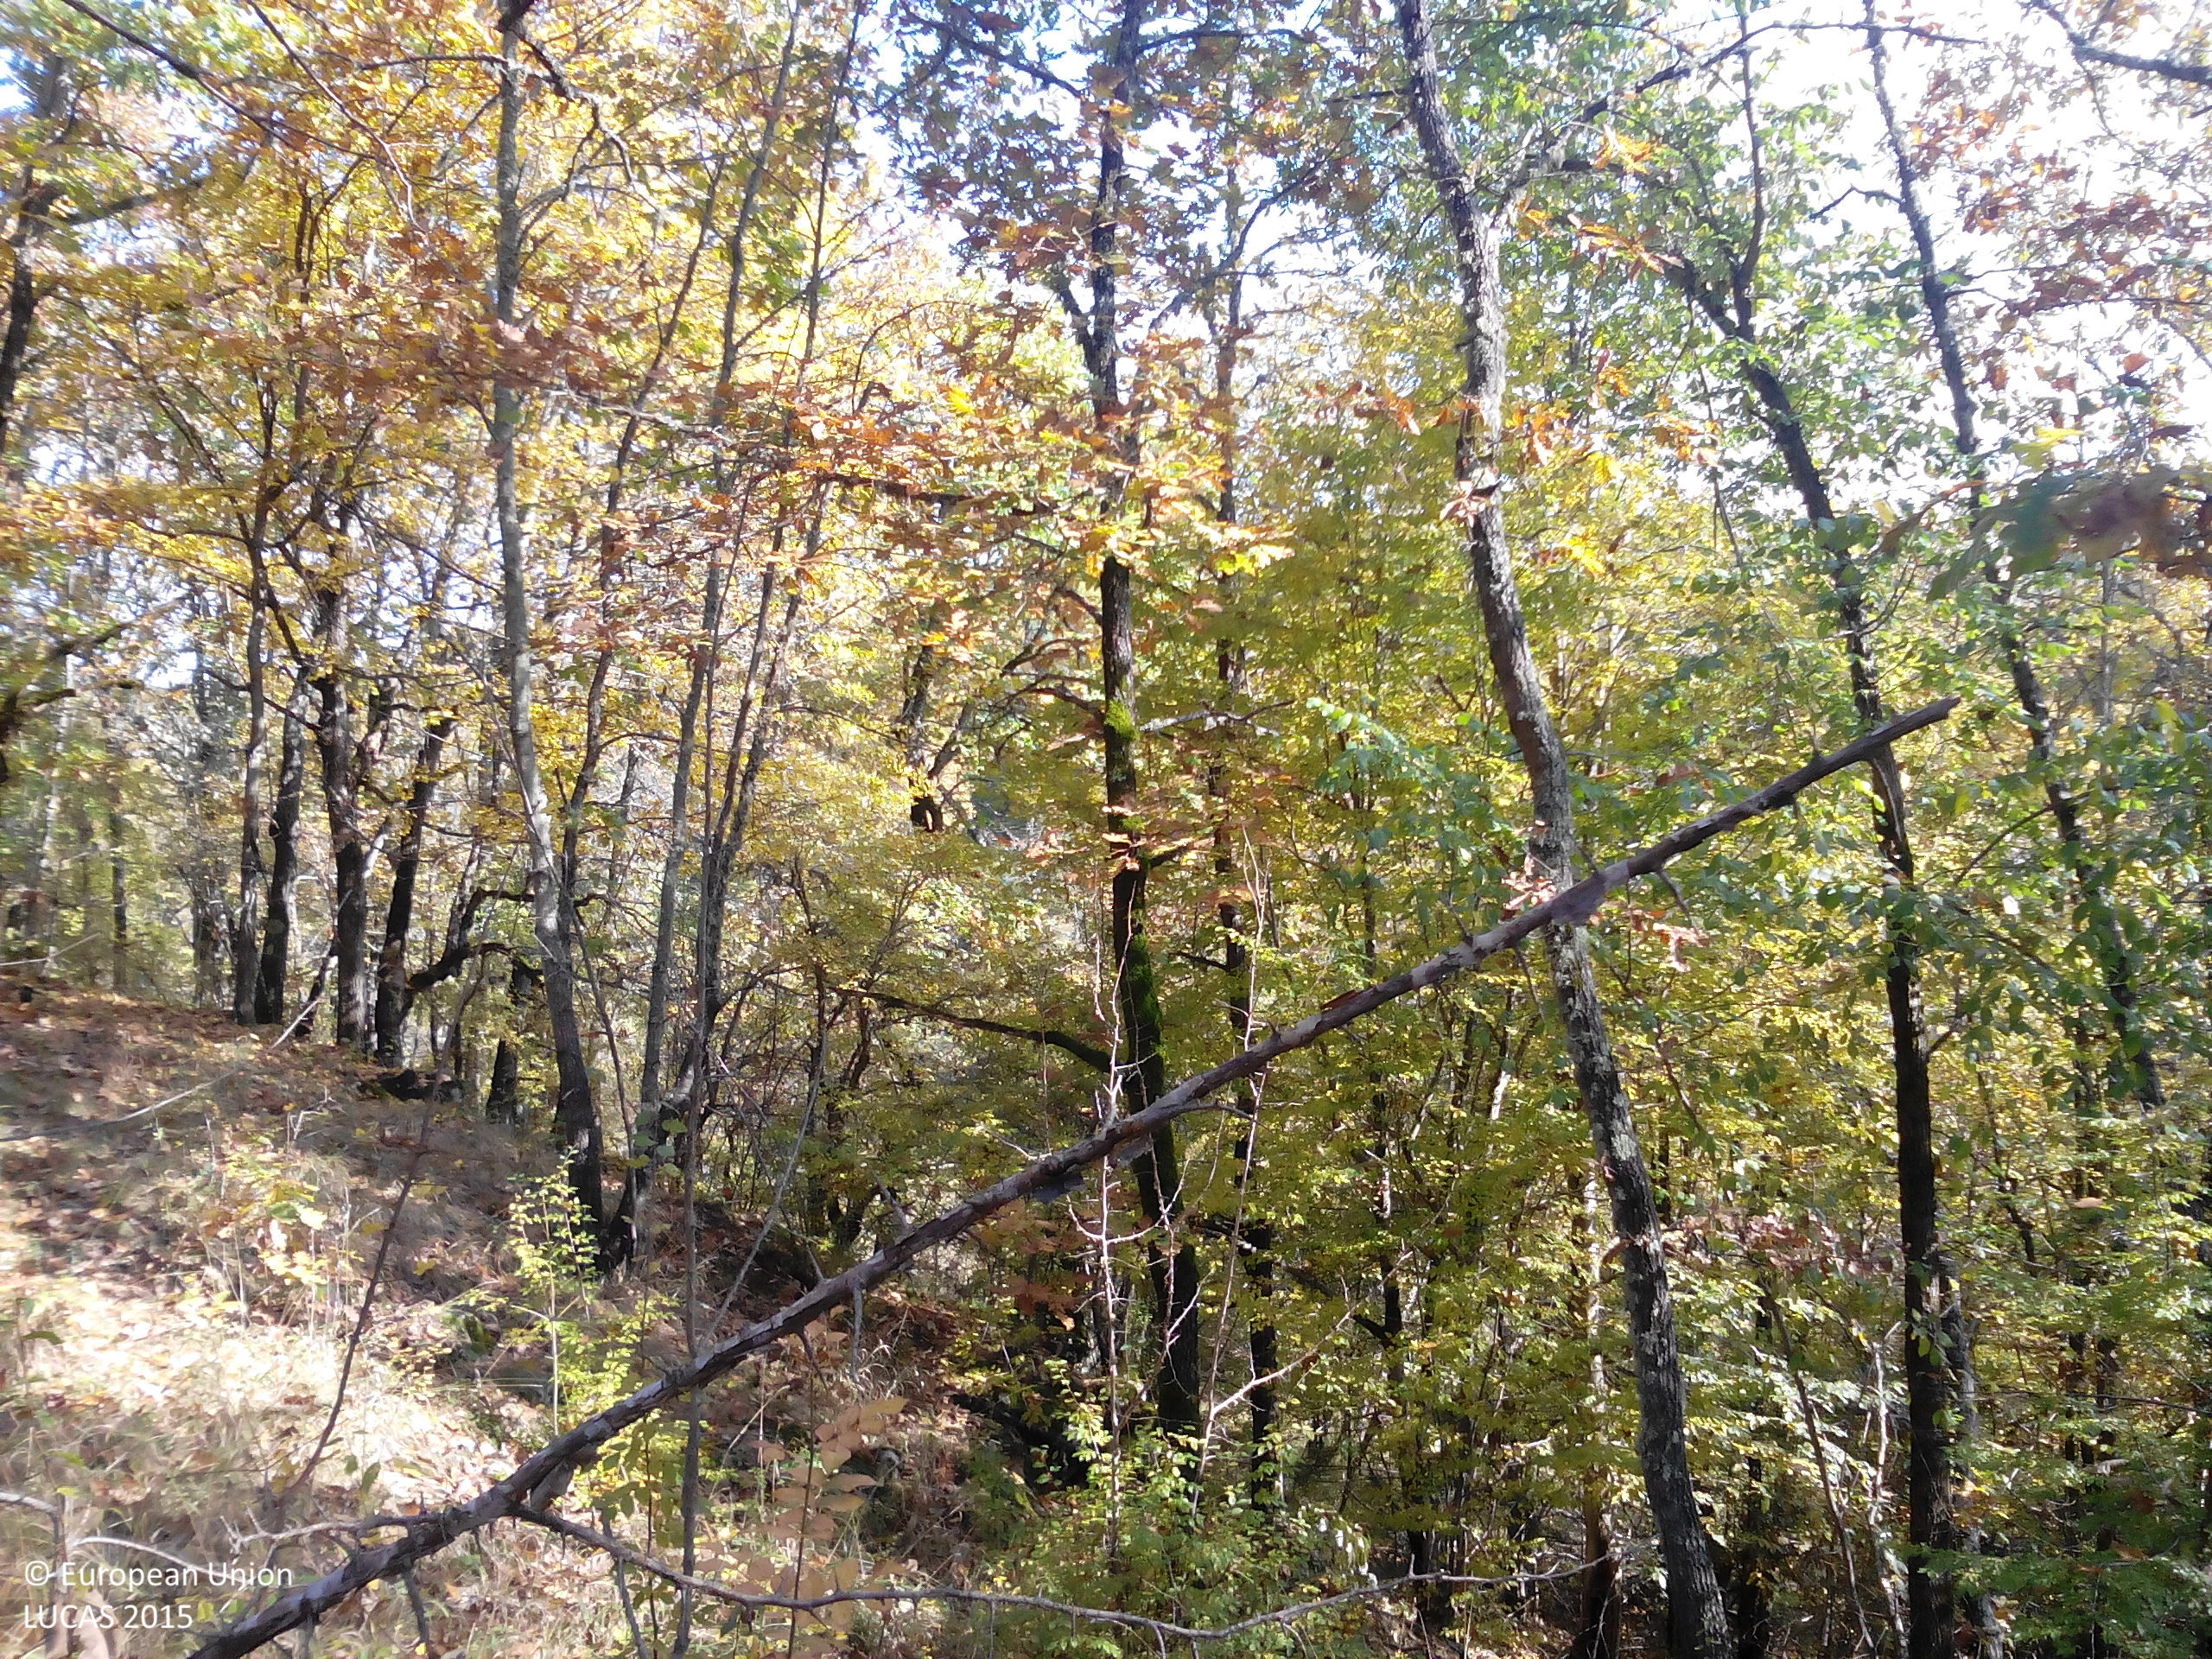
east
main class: Woodland
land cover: Broadleaved woodland
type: acidophilous oak and oak-birch forest
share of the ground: > 75 %
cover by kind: broadleaved forest trees 95 %, shrubs 5 %
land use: Forestry
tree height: > 5 m
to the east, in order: Broadleaved woodland; Grassland with sparse tree/shrub cover; Broadleaved woodland; Rivers and streams; Broadleaved woodland
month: October
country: BG
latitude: 43.0678
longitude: 24.5113
